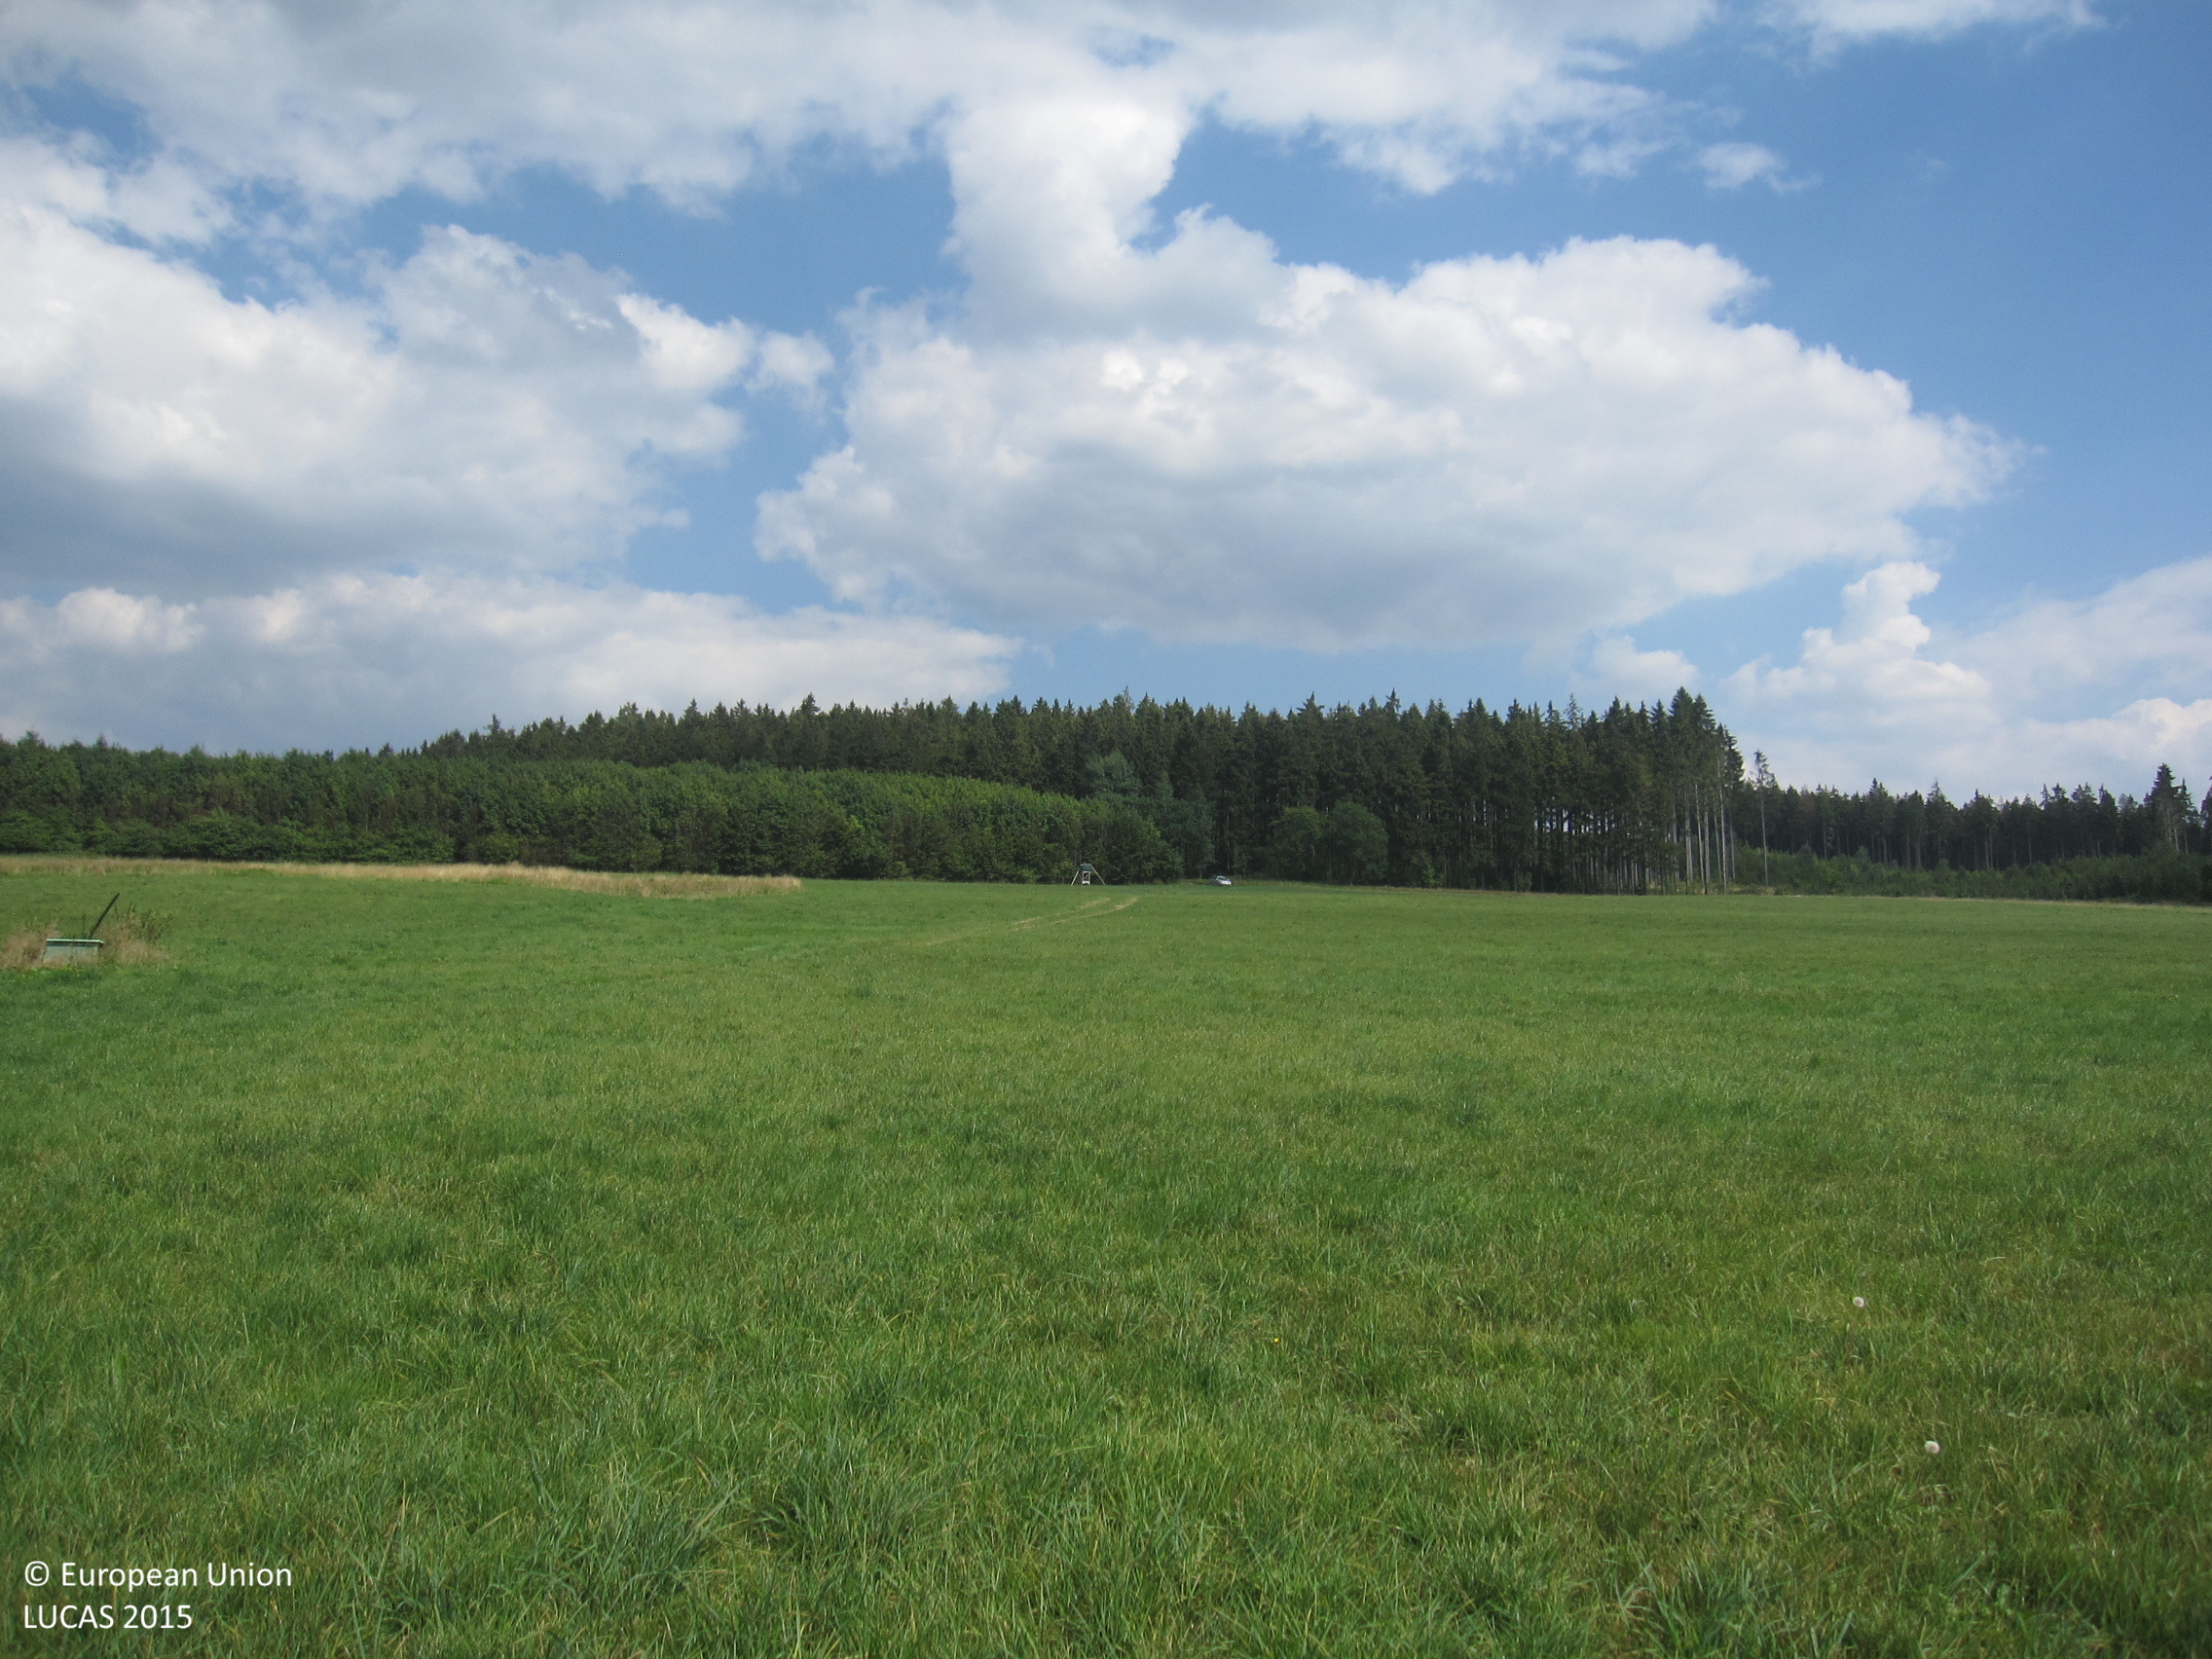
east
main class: Grassland
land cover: Grassland without tree/shrub cover
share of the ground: > 75 %
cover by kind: herbaceous plants 95 %, unconsolidated bare surface 5 %
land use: Agriculture (excluding fallow land and kitchen gardens)
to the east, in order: Grassland without tree/shrub cover; Tracks; Grassland without tree/shrub cover; Broadleaved woodland; Tracks
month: August
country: DE
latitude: 50.4249
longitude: 11.5902
